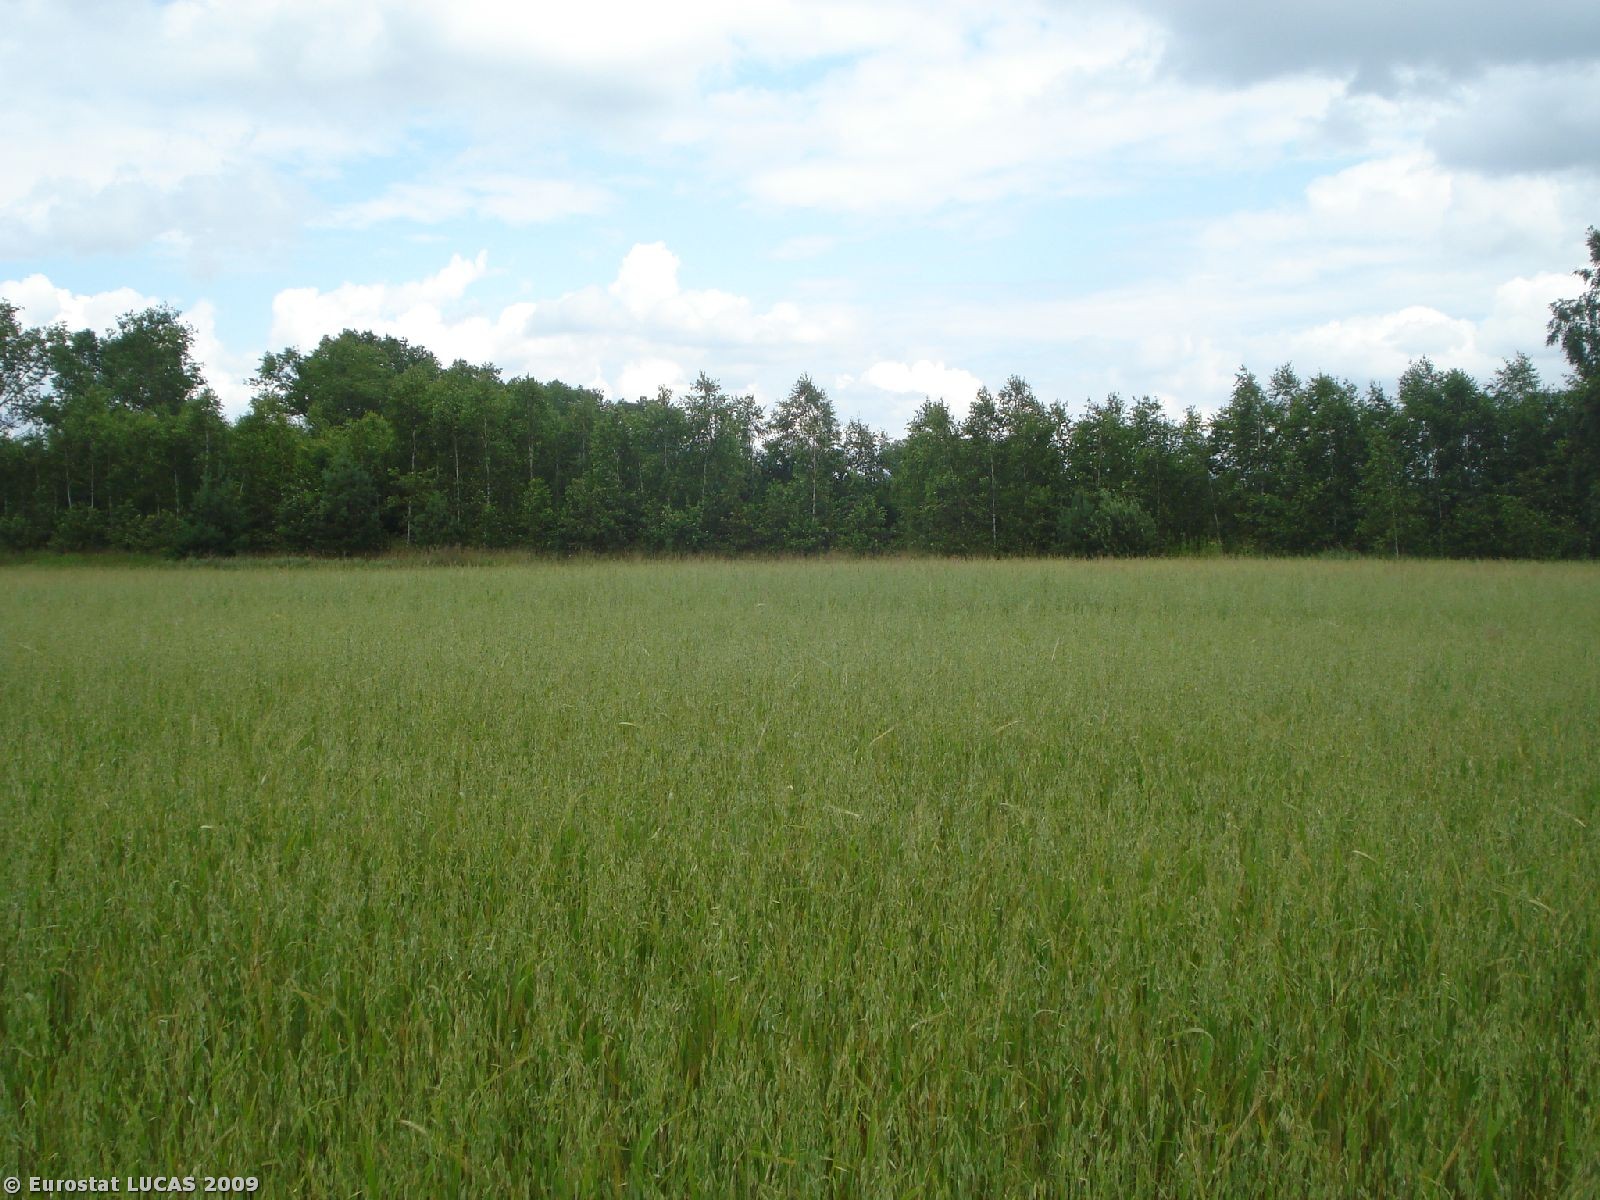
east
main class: Cropland
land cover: Oats
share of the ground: > 75 %
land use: Agriculture (excluding fallow land and kitchen gardens)
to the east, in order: Oats; Grass margins; Oats; Grassland with sparse tree/shrub cover; Tracks; Coniferous woodland; Grassland with sparse tree/shrub cover
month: July
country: PL
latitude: 51.2883
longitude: 23.0528
